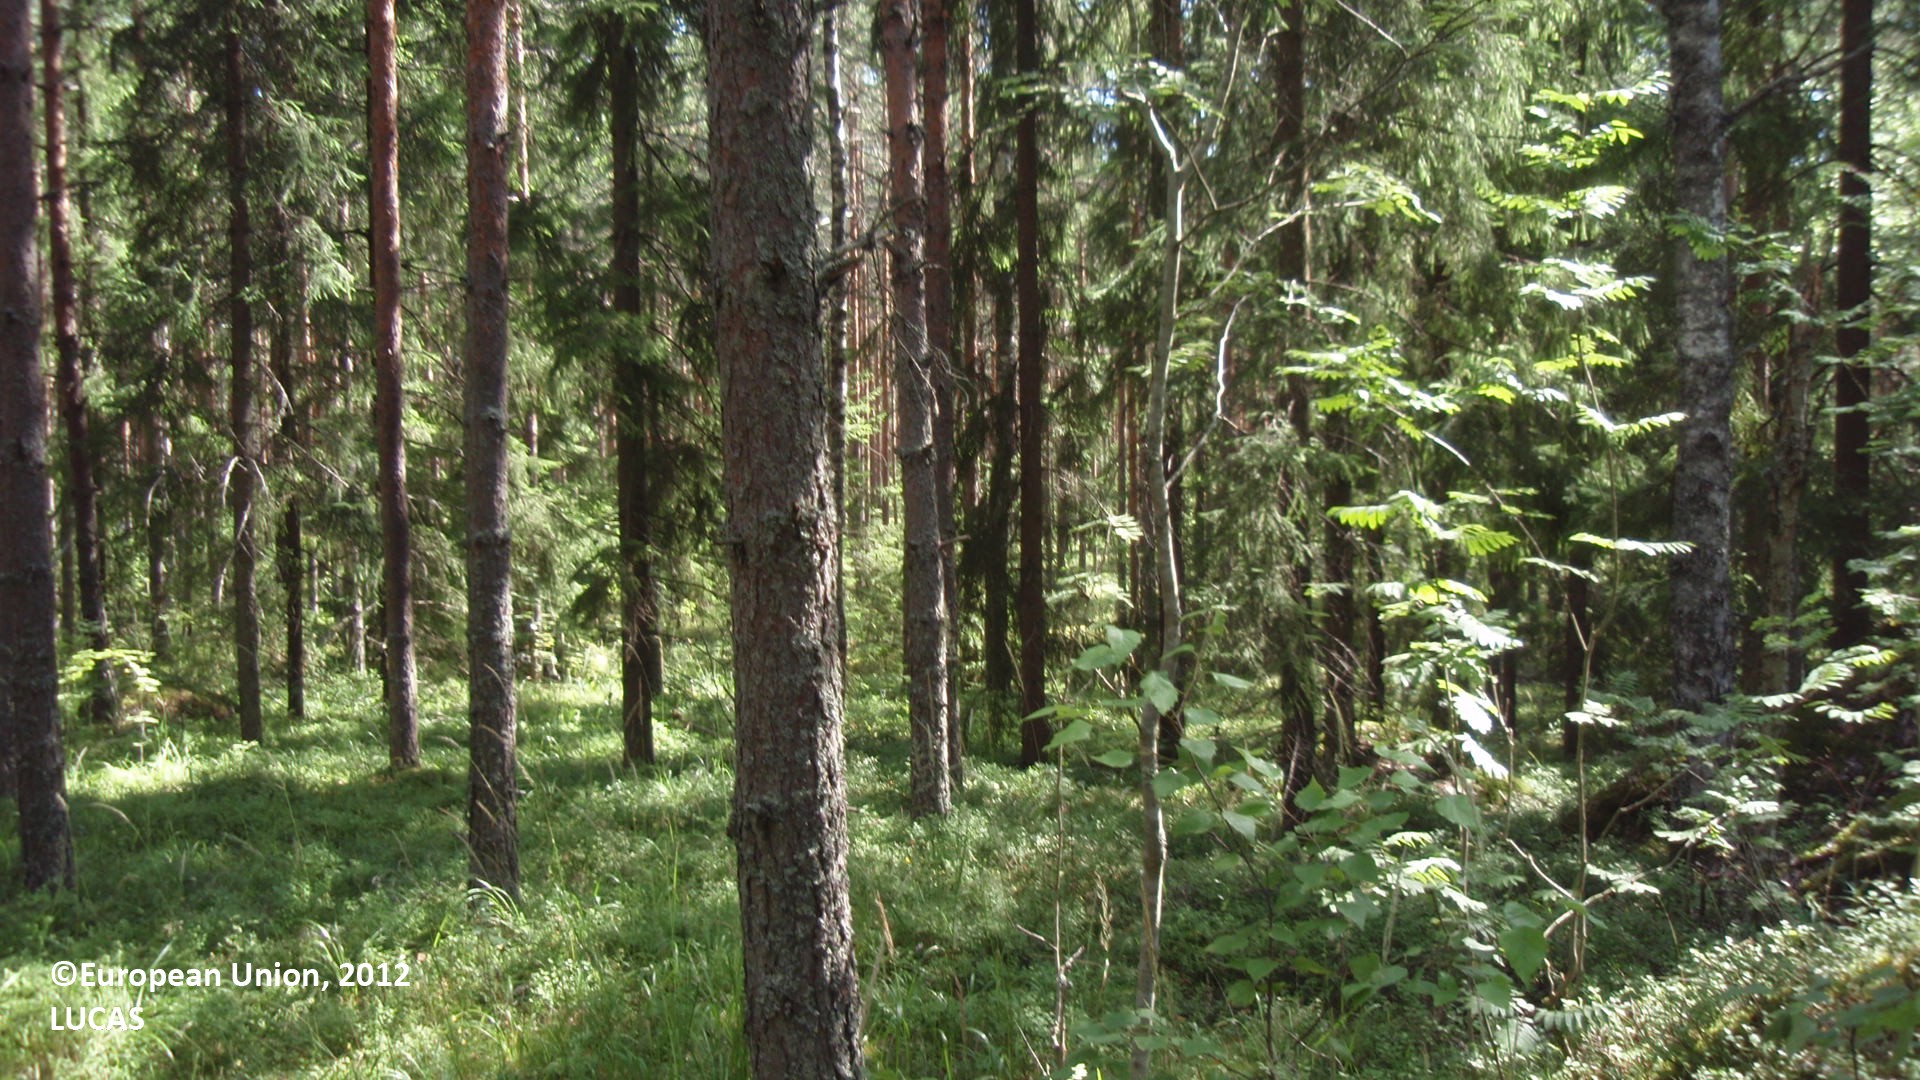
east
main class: Woodland
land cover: Pine dominated mixed woodland
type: boreal forest
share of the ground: 50 - 75 %
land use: Forestry
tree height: > 5 m
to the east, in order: Pine dominated mixed woodland; Ditches and canals; Pine dominated mixed woodland
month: August
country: FI
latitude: 60.9998
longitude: 28.6578
